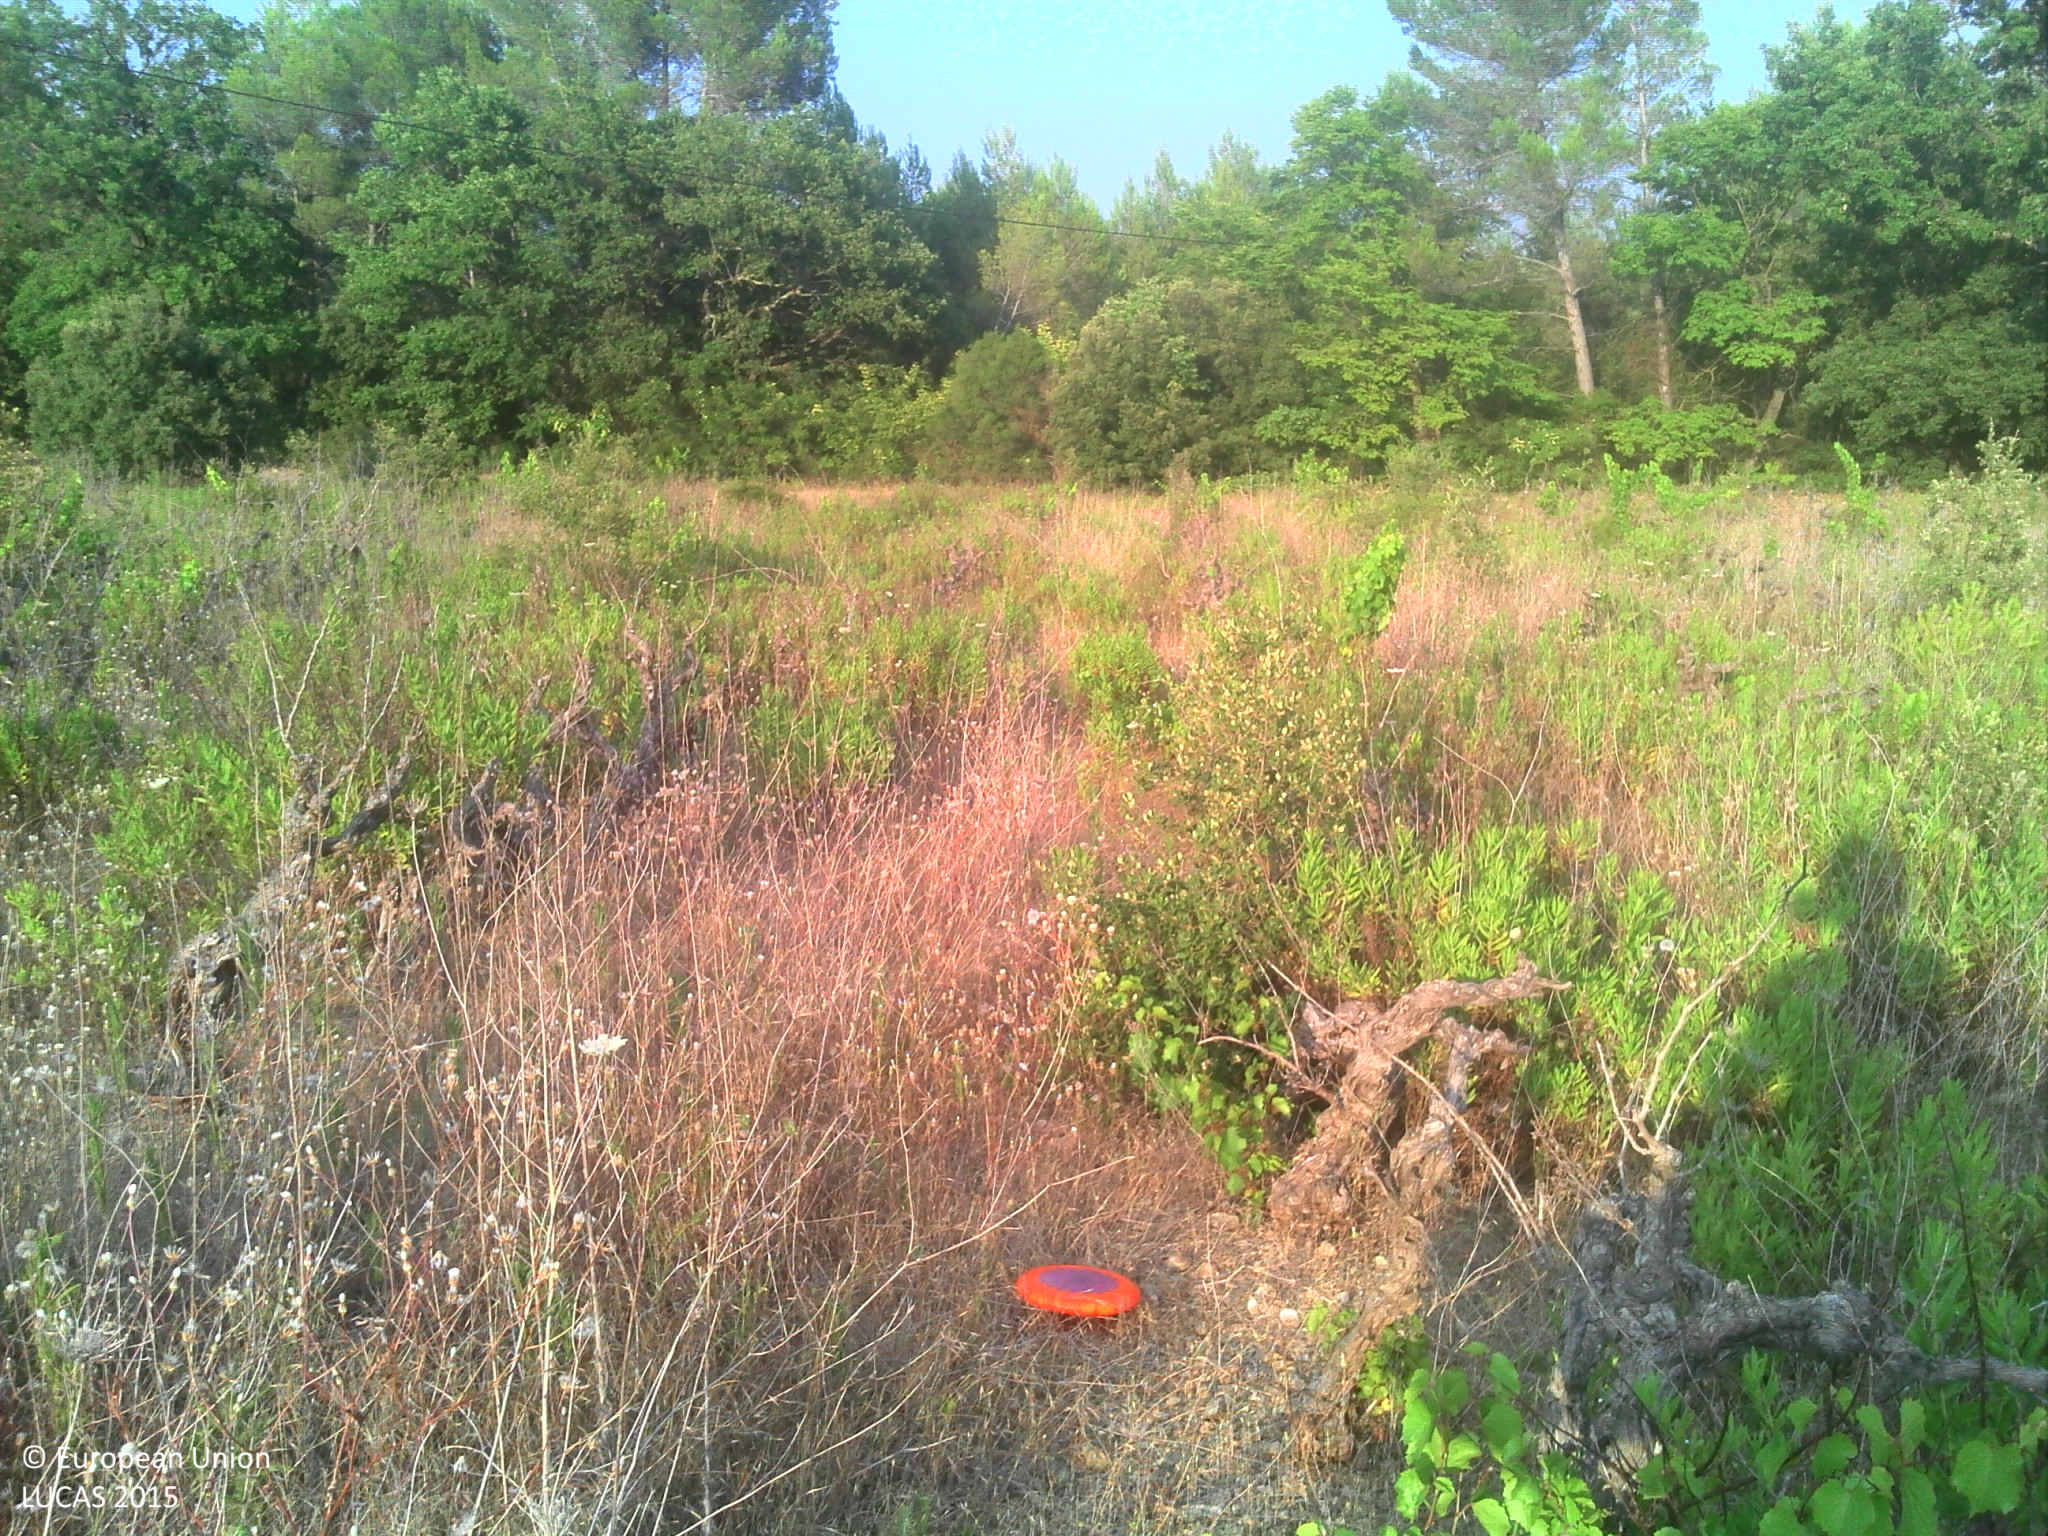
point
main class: Cropland
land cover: Vineyards
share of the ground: 25 - 50 %
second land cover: Grassland without tree/shrub cover
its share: > 75 %
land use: Abandoned areas
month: July
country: FR
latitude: 43.4192
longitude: 6.3407
